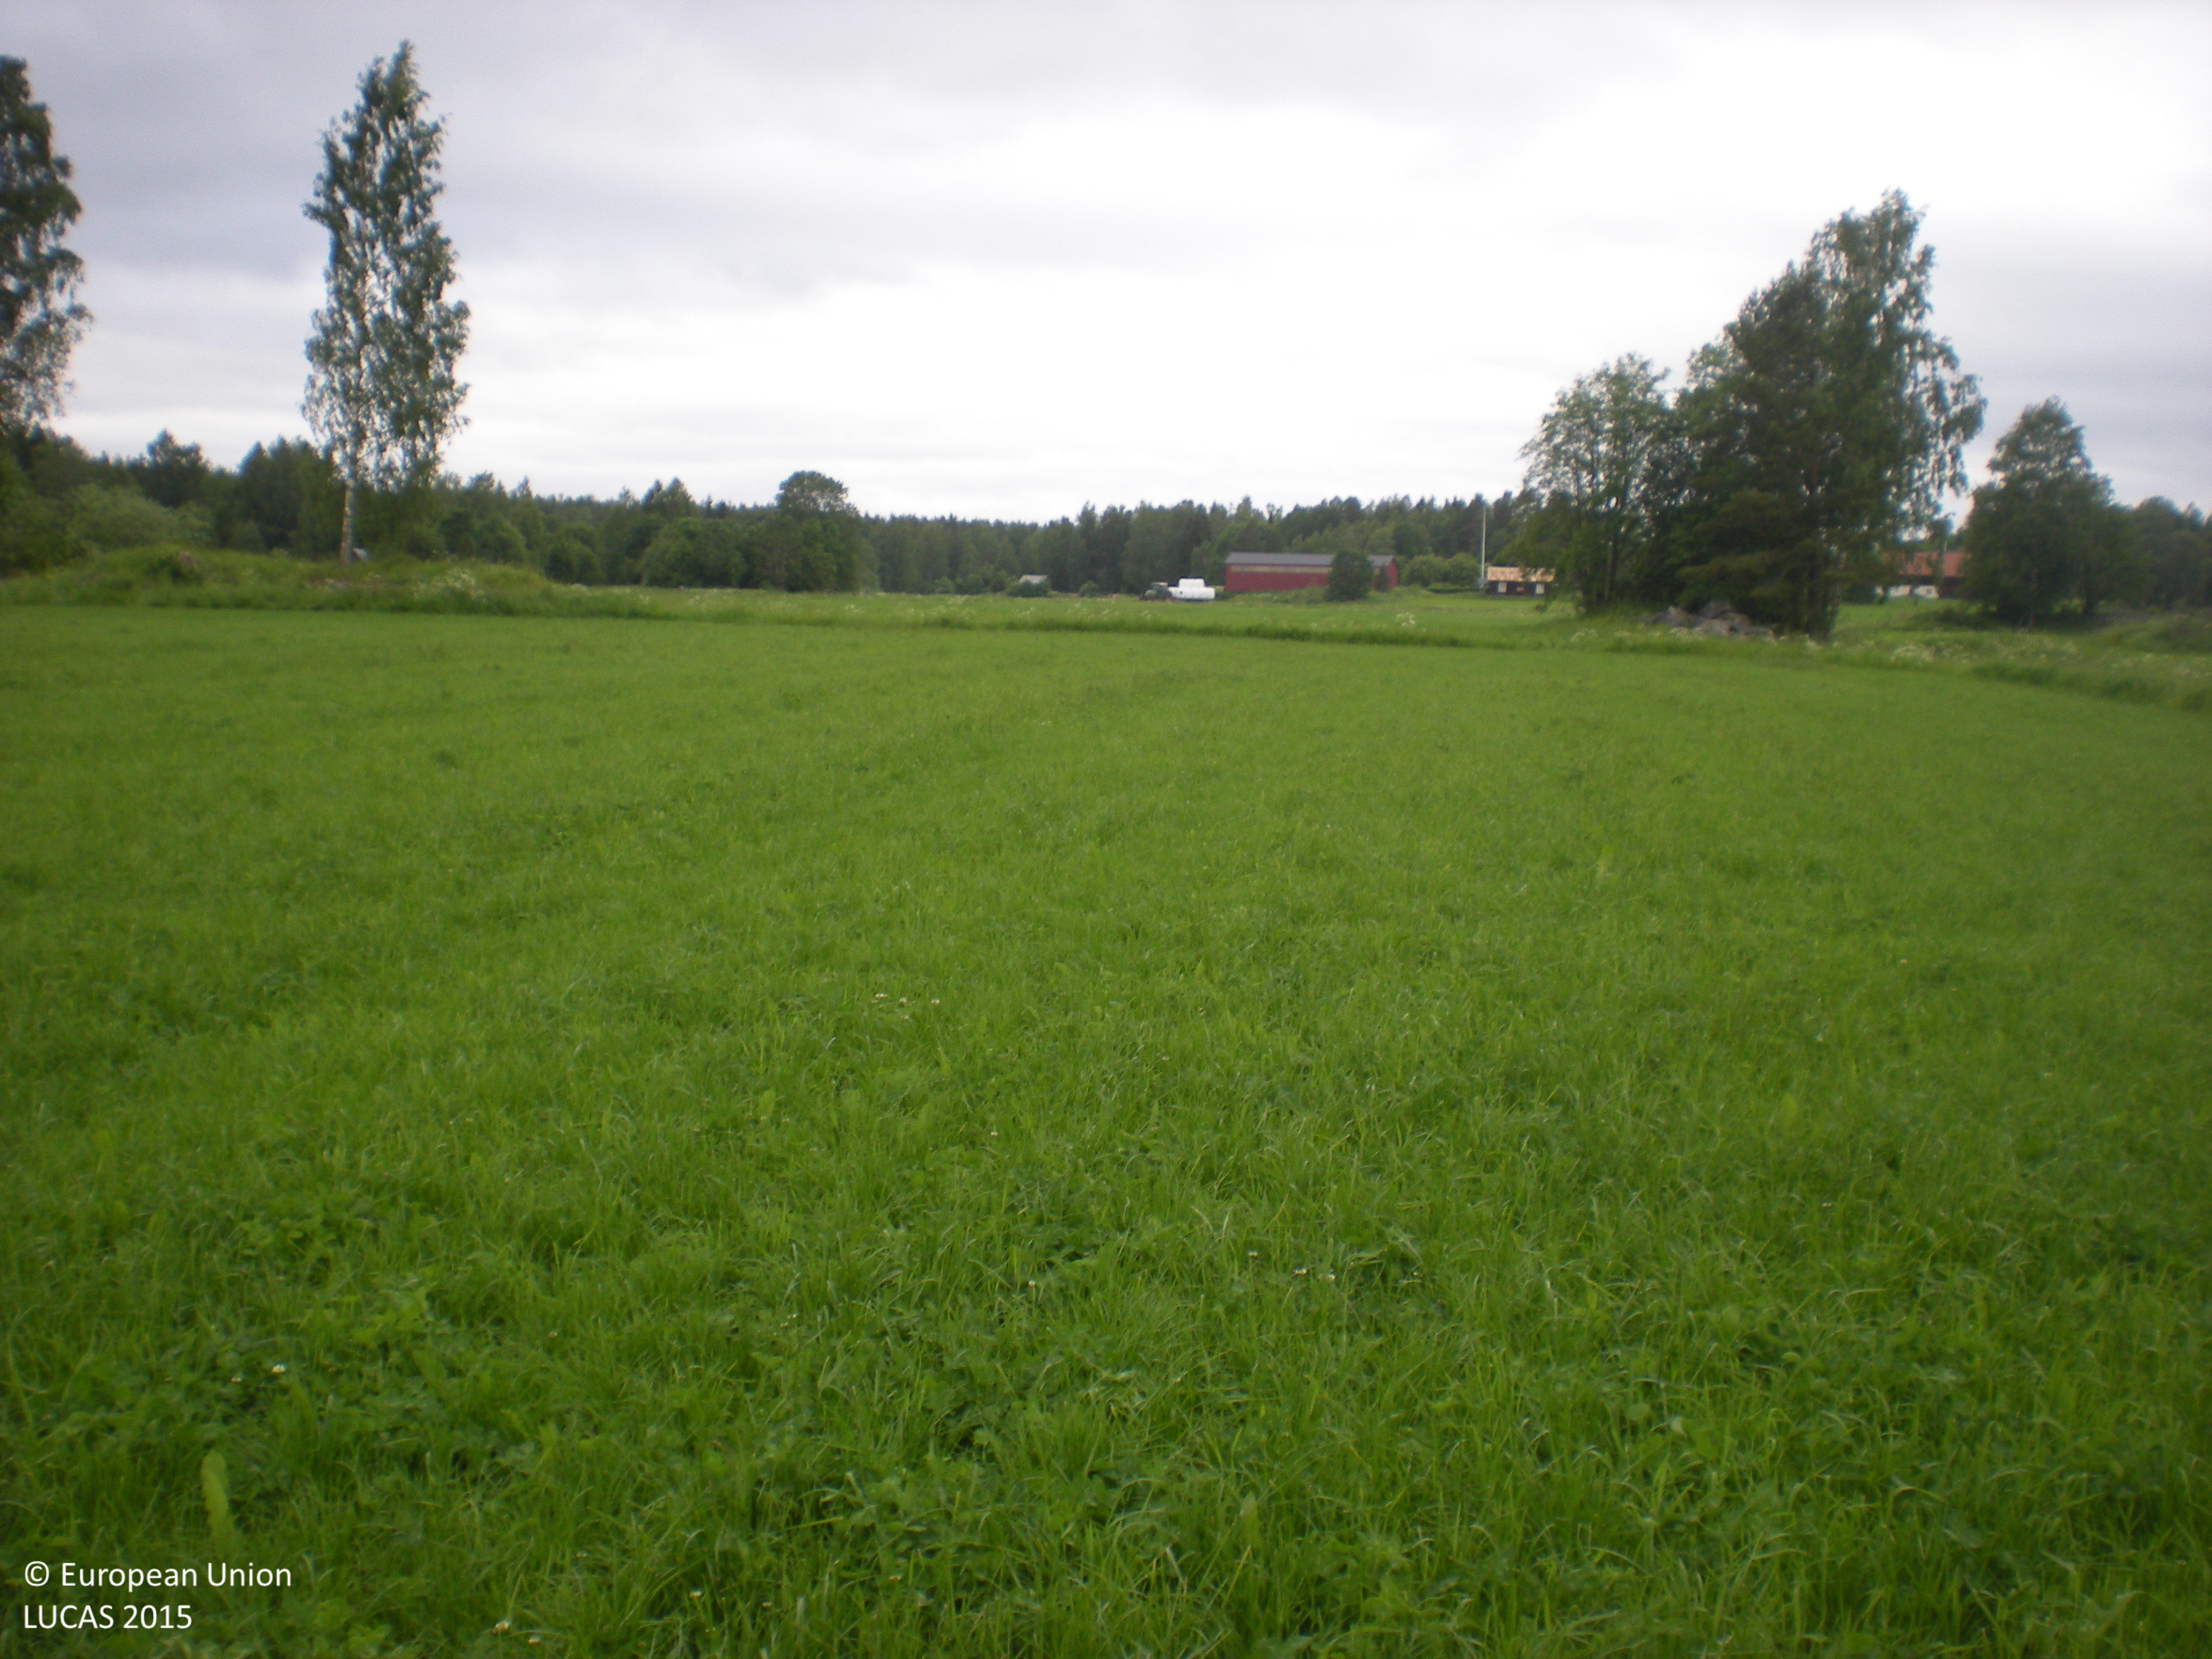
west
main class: Cropland
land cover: Other leguminous and mixtures for fodder
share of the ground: > 75 %
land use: Agriculture (excluding fallow land and kitchen gardens)
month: June
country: SE
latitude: 60.3665
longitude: 17.7343
